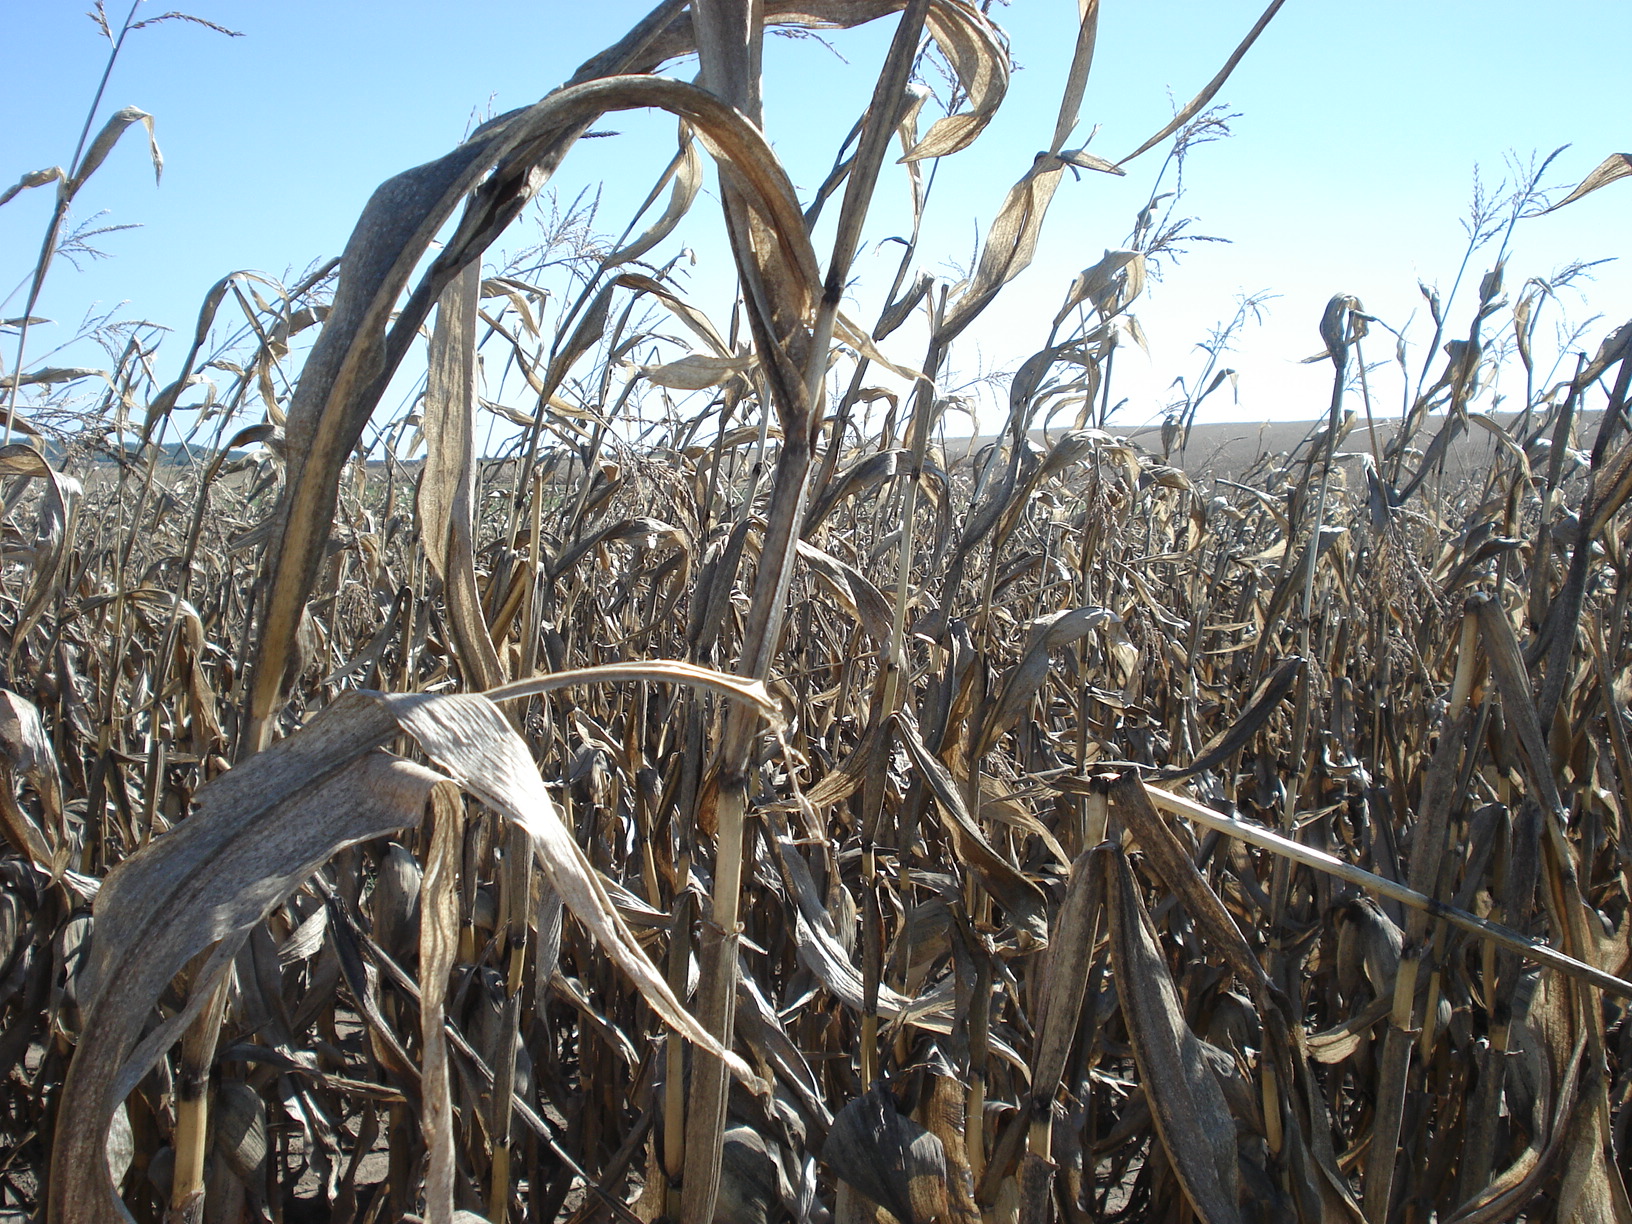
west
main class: Cropland
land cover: Maize
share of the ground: > 75 %
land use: Agriculture (excluding fallow land and kitchen gardens)
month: September
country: BG
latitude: 43.3211
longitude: 25.2792
